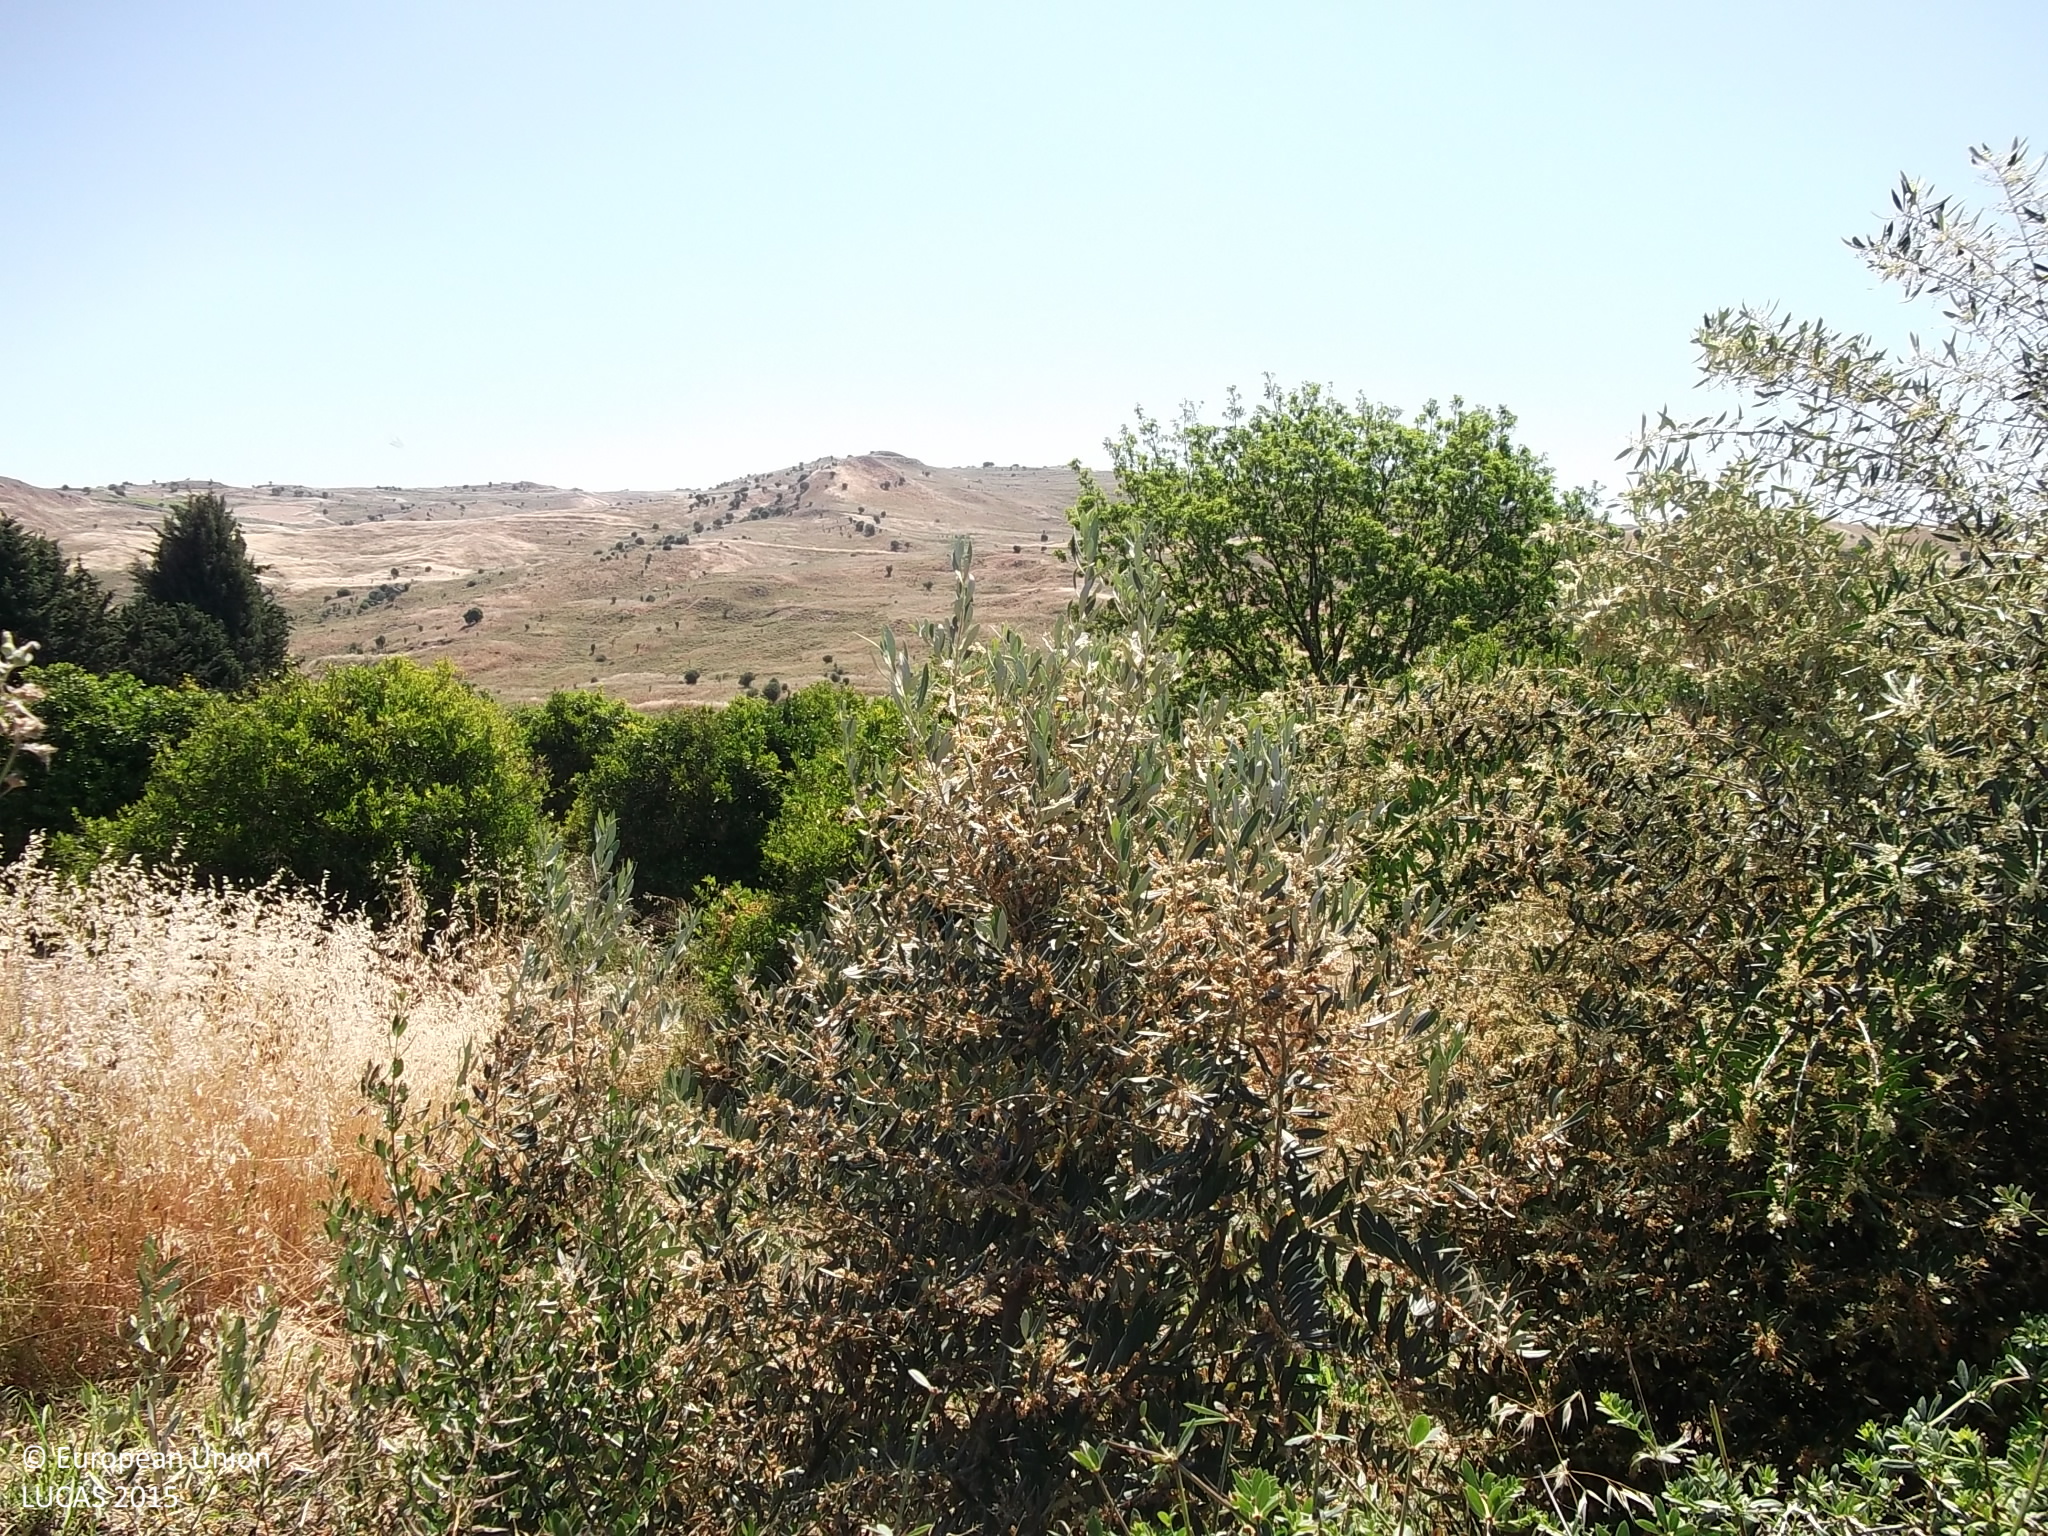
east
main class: Cropland
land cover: Oranges
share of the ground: > 75 %
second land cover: Olive groves
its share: 10 - 25 %
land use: Agriculture (excluding fallow land and kitchen gardens)
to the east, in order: Oranges; Olive groves; Fences; Other bare soil; Oranges; Pine dominated coniferous woodland; Oranges; Shrubland without tree cover; Electric lines; Shrubland without tree cover; Inland fresh running water; Rocks and stones; Sand; Shrubland without tree cover
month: May
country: CY
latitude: 34.7861
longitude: 32.5871
